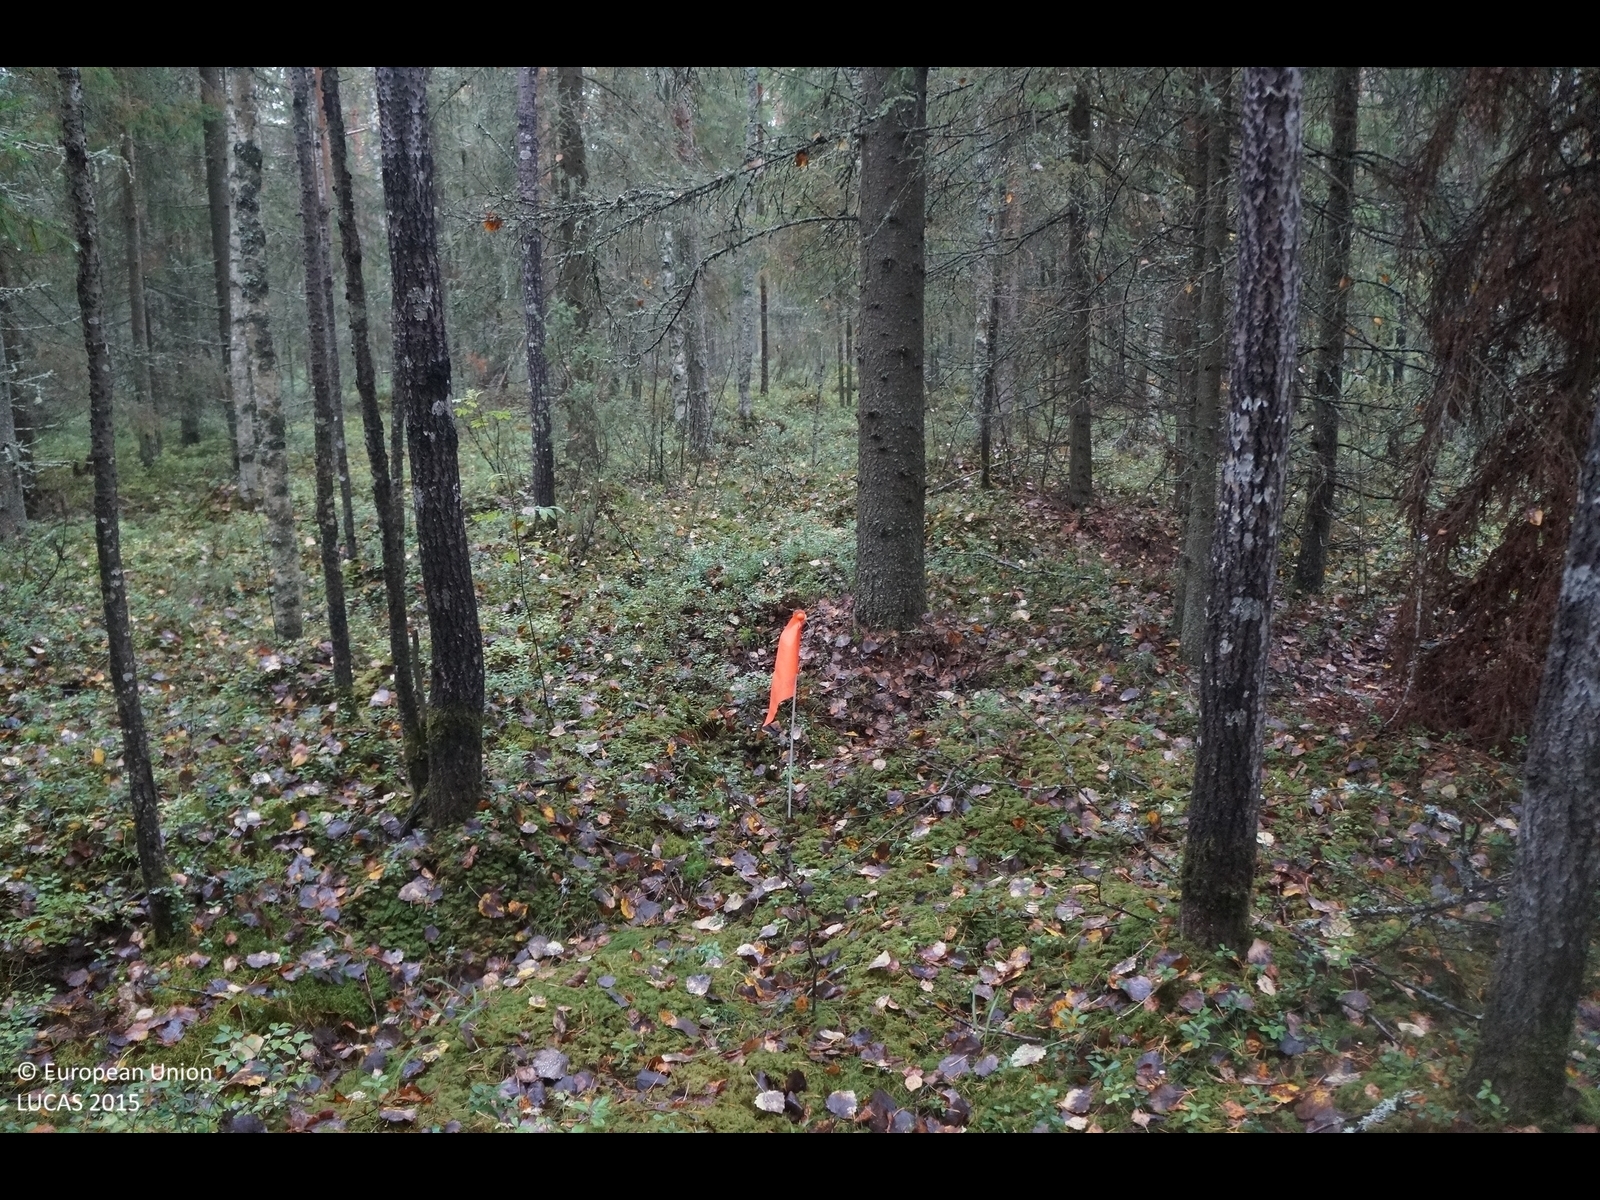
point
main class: Woodland
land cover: Spruce dominated mixed woodland
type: boreal forest
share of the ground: 50 - 75 %
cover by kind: coniferous forest trees 50 %, broadleaved forest trees 20 %, shrubs 15 %, lichens and mosses 15 %
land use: Forestry
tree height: > 5 m
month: September
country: FI
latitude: 64.1213
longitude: 24.4258
